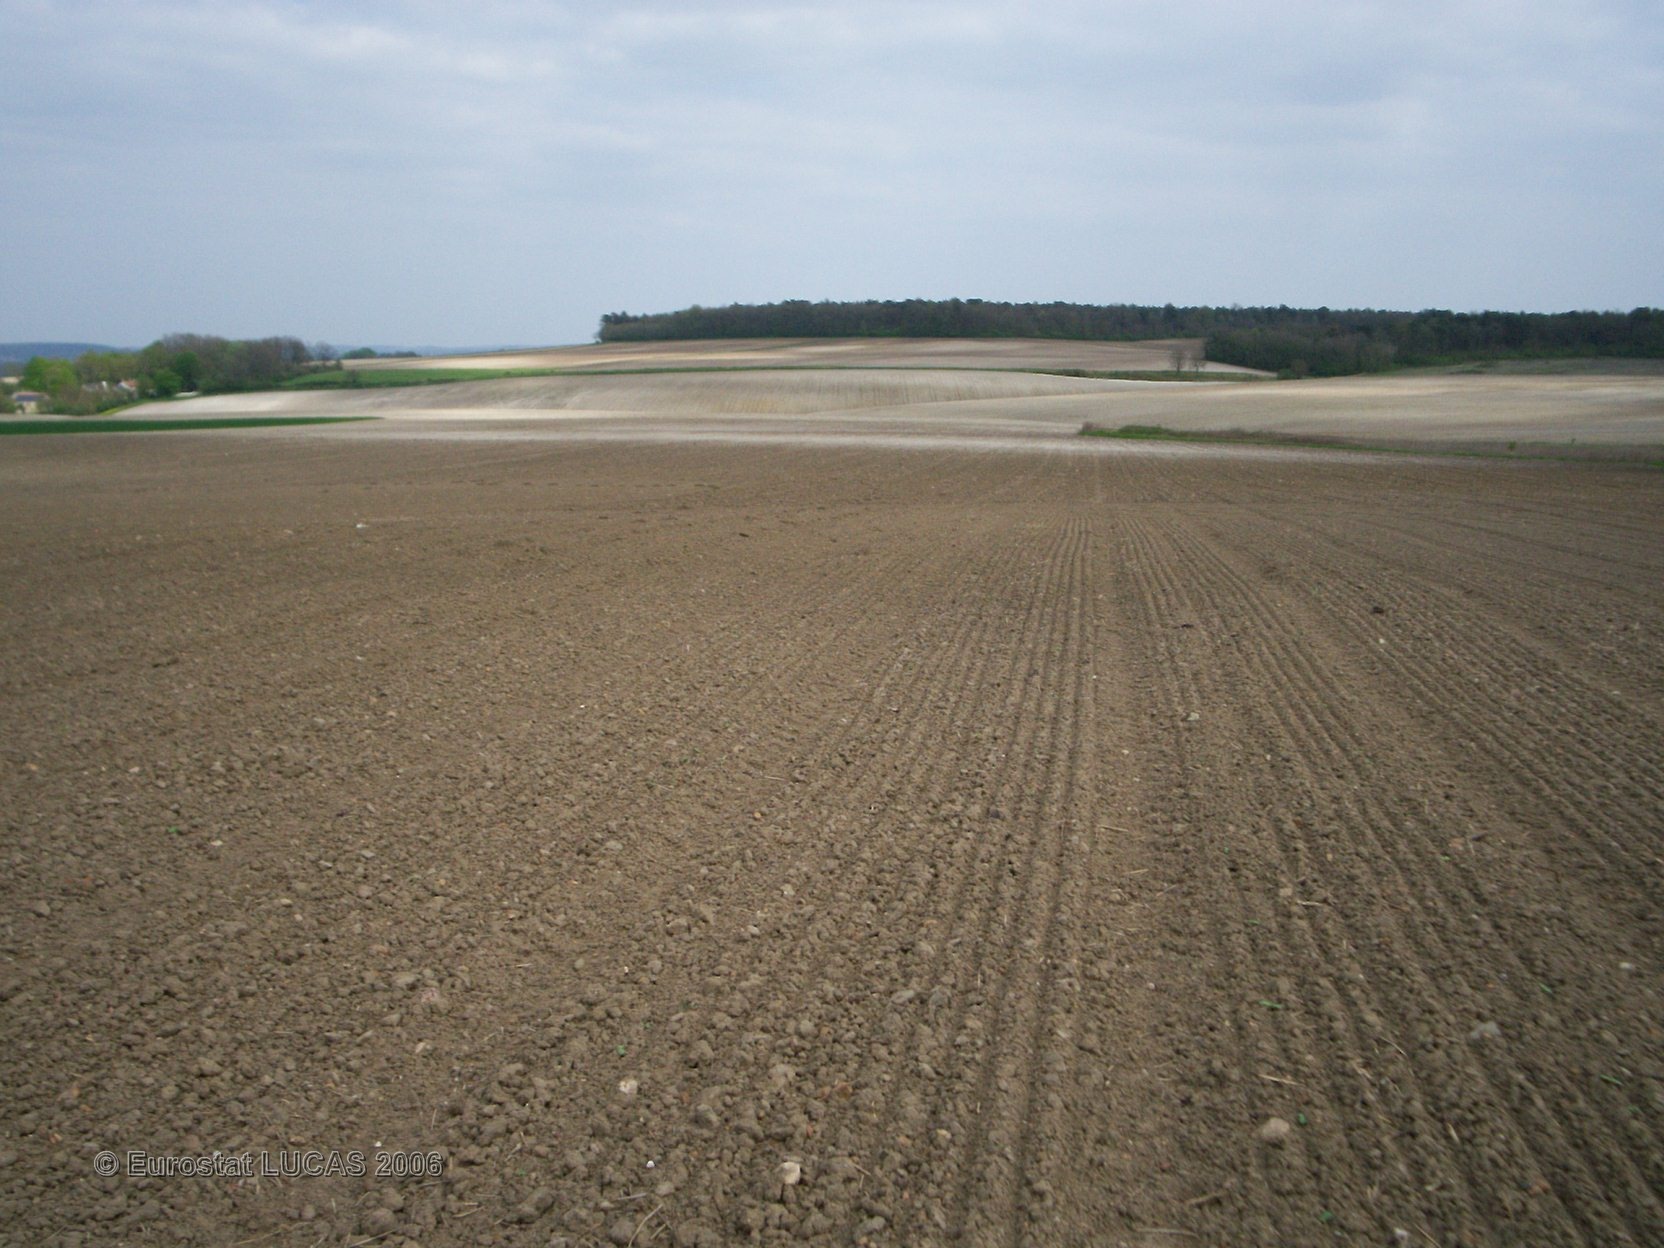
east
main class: Cropland
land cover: Sunflower
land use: Agriculture (excluding fallow land and kitchen gardens)
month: April
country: FR
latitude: 47.1257
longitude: 0.3160
